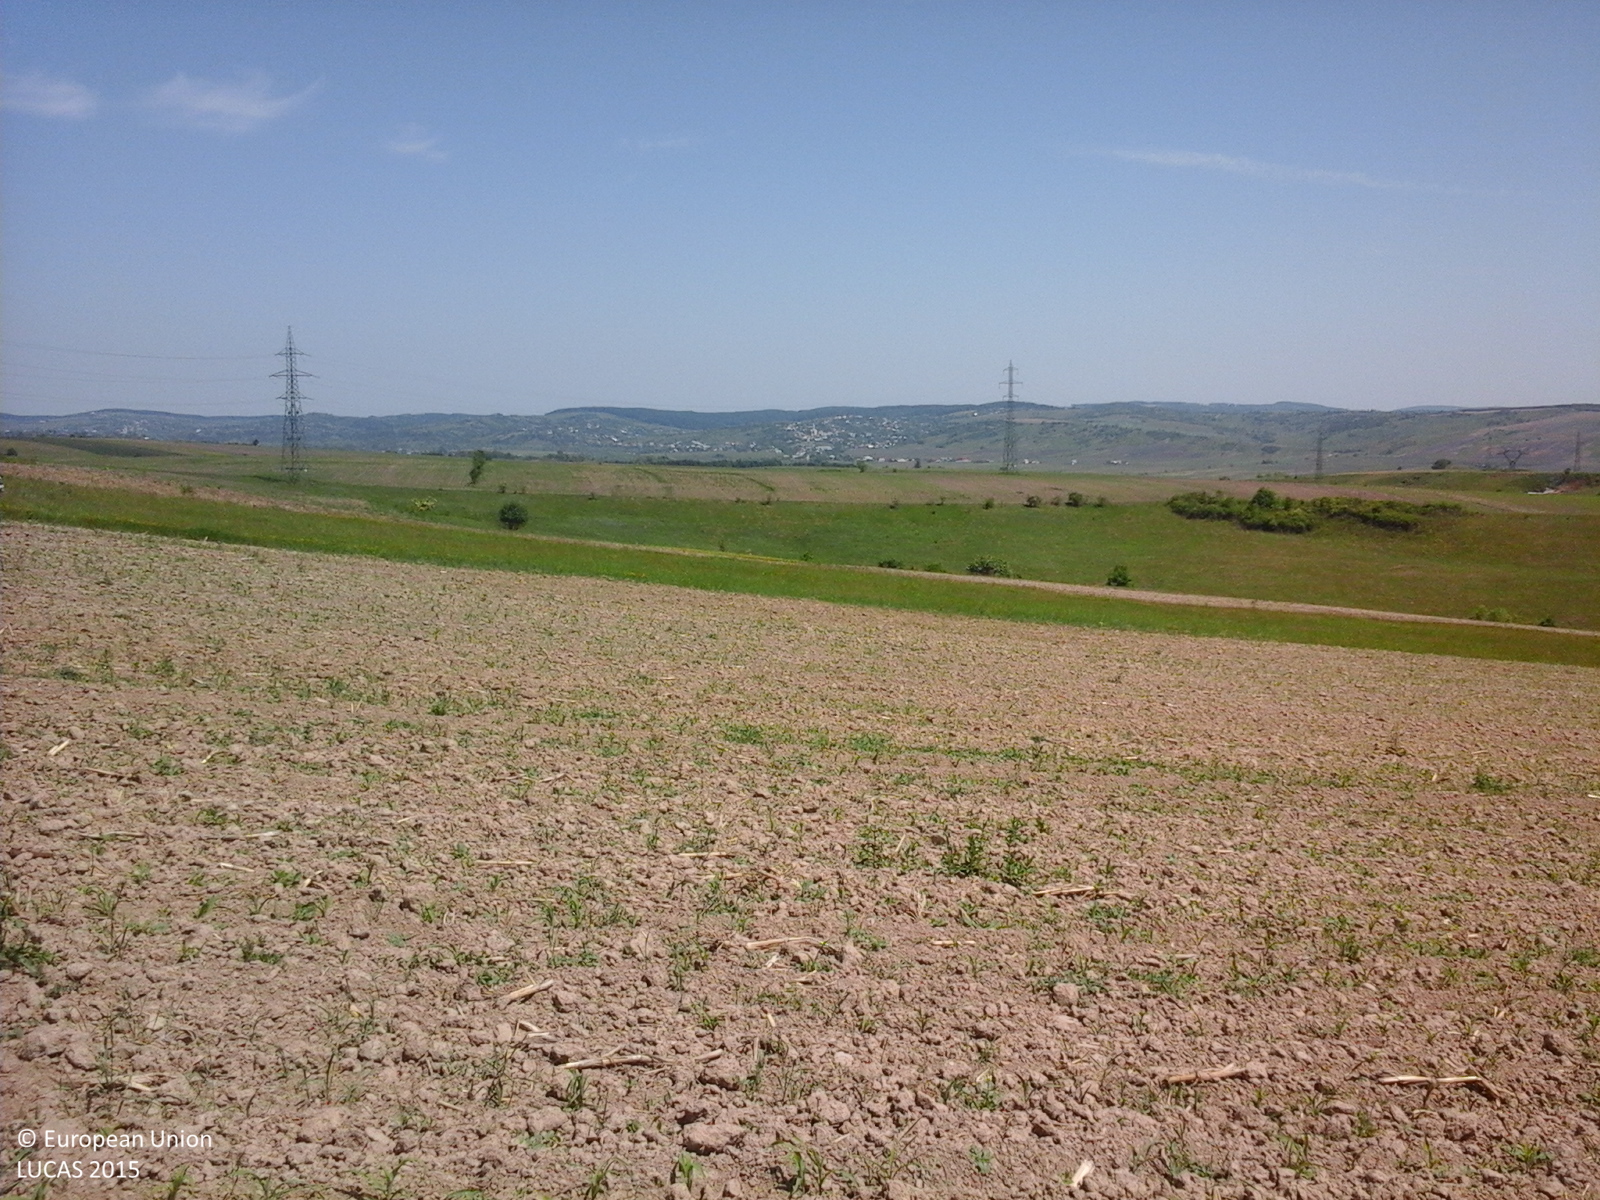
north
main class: Cropland
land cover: Maize
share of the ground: < 10 %
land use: Agriculture (excluding fallow land and kitchen gardens)
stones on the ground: < 10 %
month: June
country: RO
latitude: 46.5476
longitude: 26.6091
